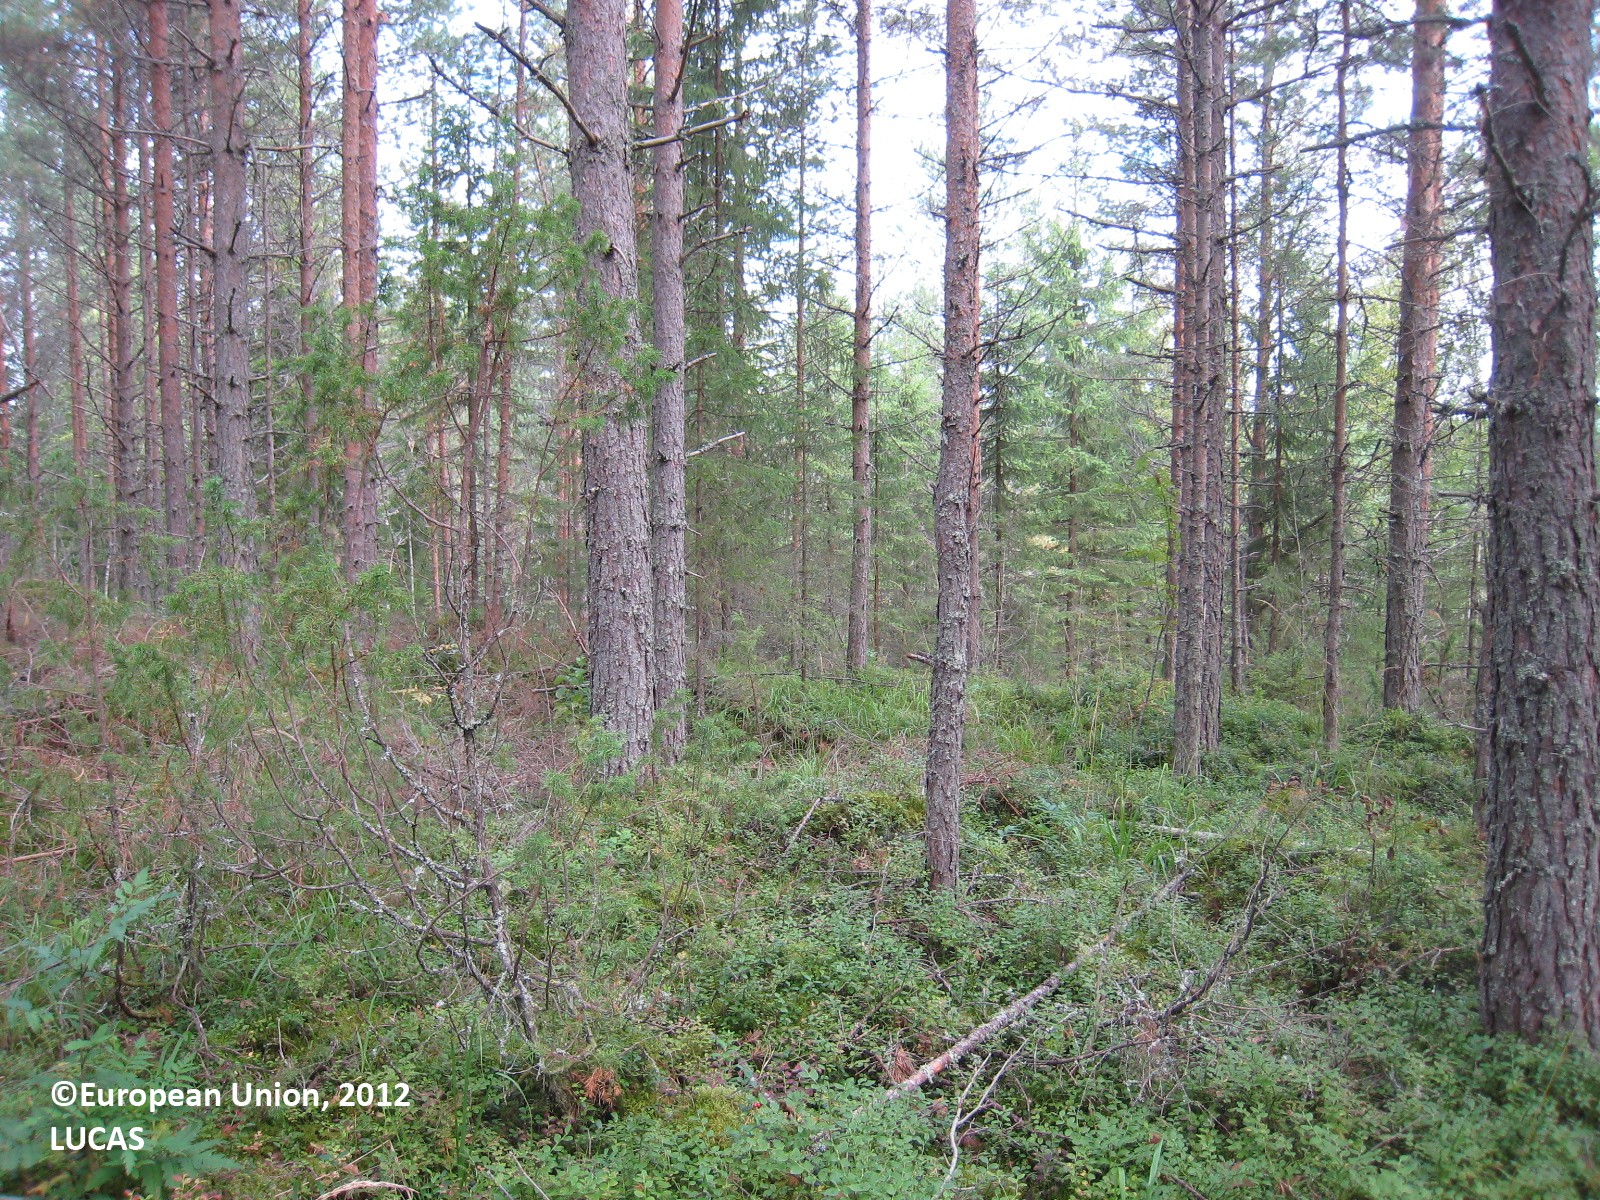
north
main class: Woodland
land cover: Pine dominated coniferous woodland
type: boreal forest
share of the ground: > 75 %
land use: Forestry
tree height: > 5 m
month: August
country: FI
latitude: 62.1372
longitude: 27.2924
